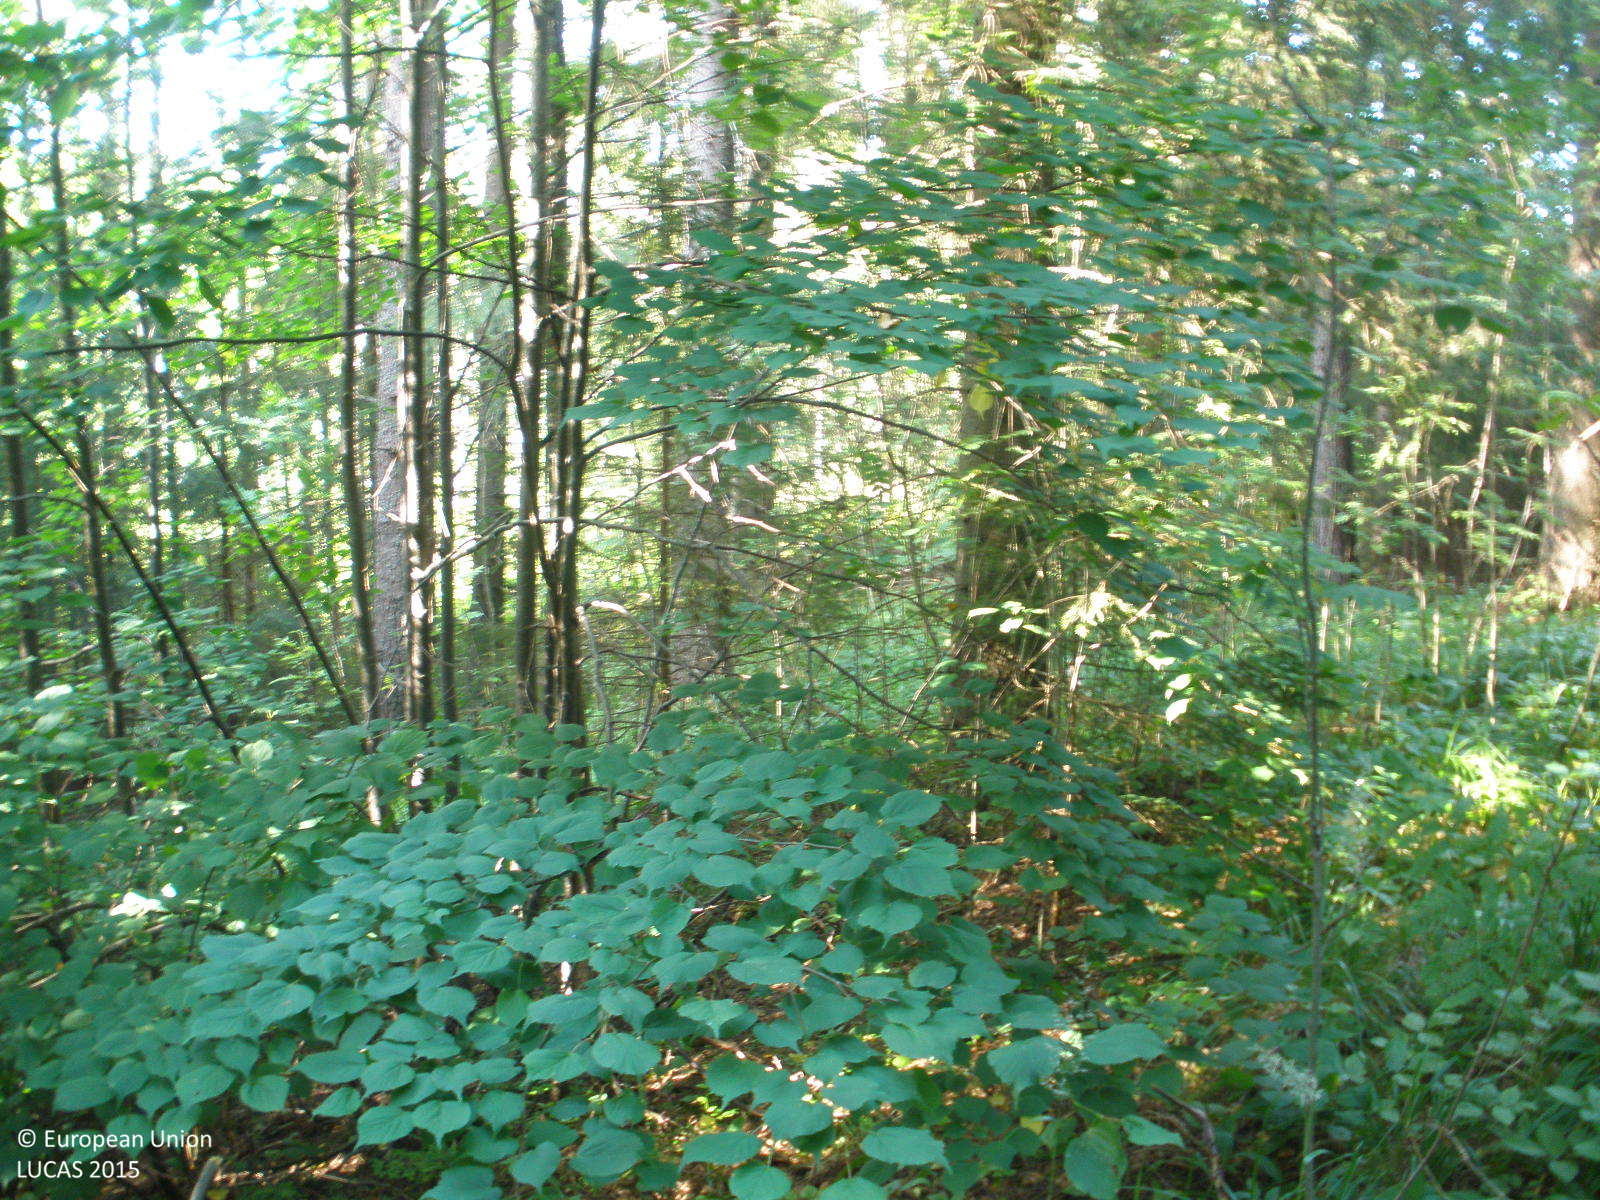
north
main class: Woodland
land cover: Spruce dominated mixed woodland
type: boreal forest
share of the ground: > 75 %
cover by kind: coniferous forest trees 65 %, broadleaved forest trees 25 %, herbaceous plants 10 %
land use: Forestry
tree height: > 5 m
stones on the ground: < 10 %
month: August
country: FI
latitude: 60.9740
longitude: 24.7974
